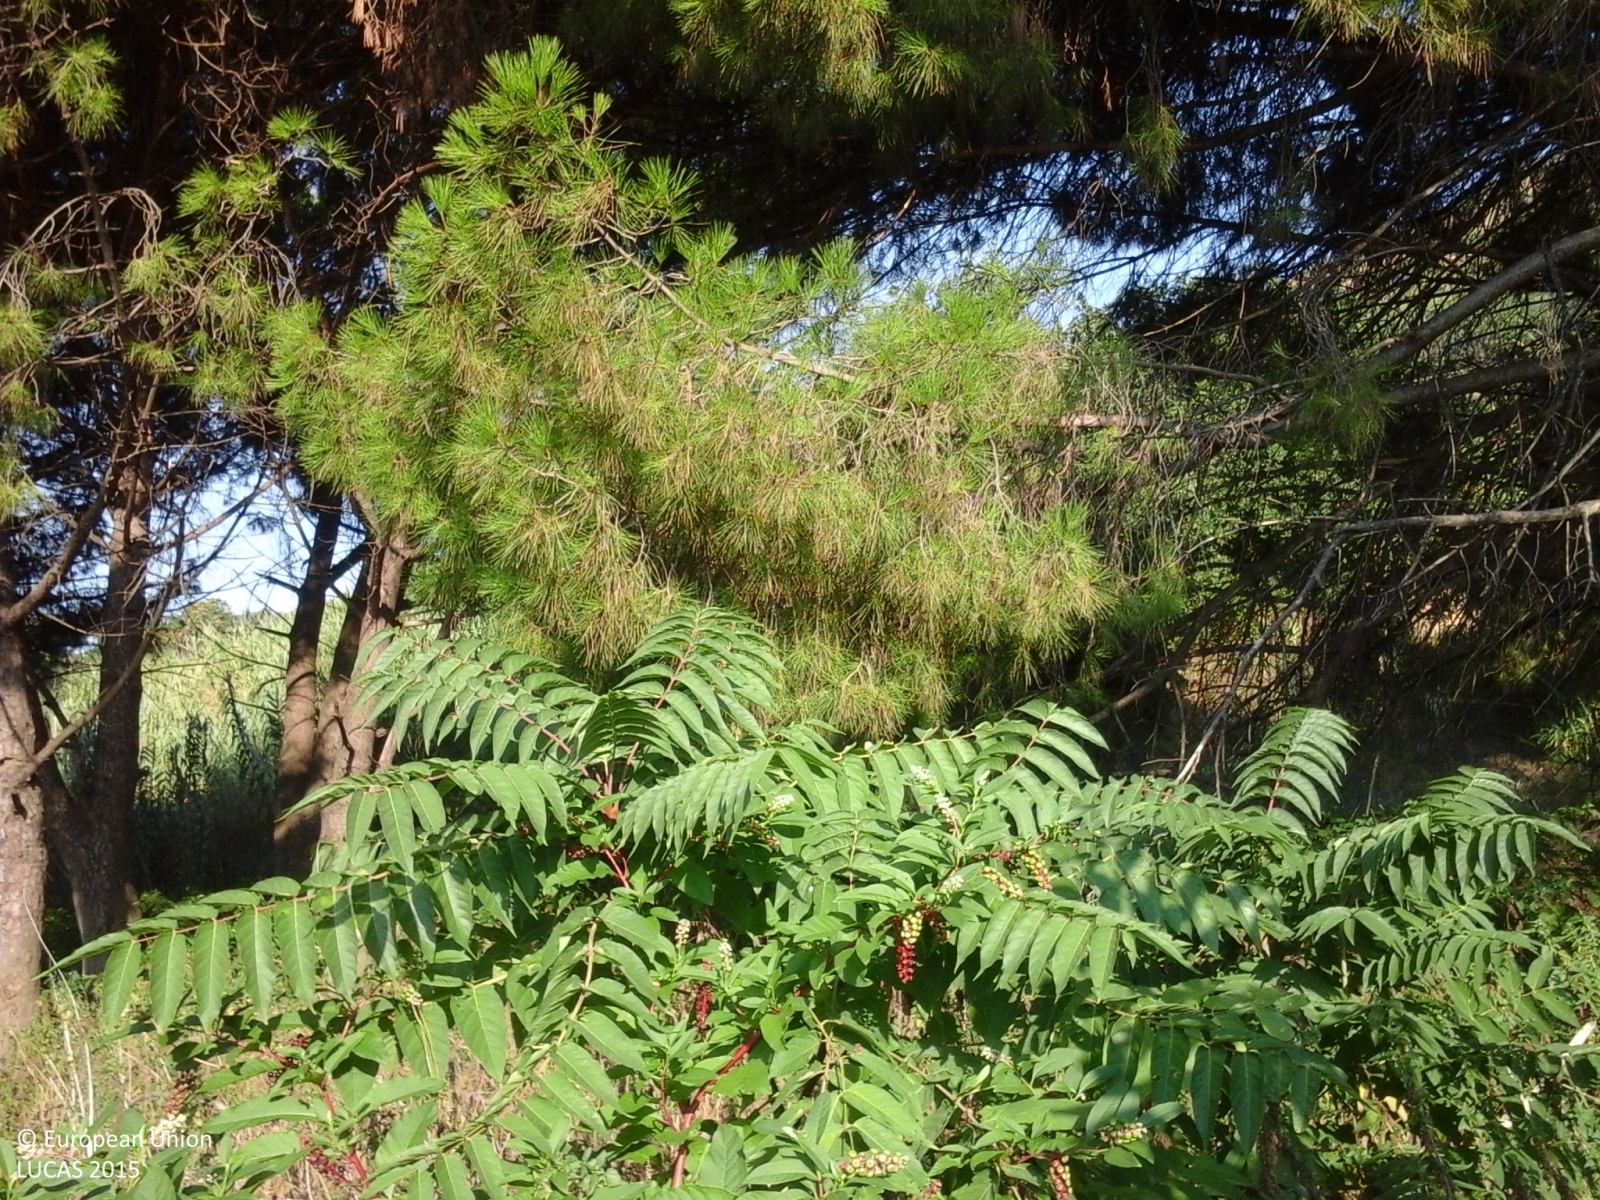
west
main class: Shrubland
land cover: Shrubland with sparse tree cover
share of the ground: > 75 %
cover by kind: shrubs 50 %, herbaceous plants 30 %, broadleaved forest trees 5 %
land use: Semi-natural and natural areas not in use
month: September
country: IT
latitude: 40.7727
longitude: 14.6607
